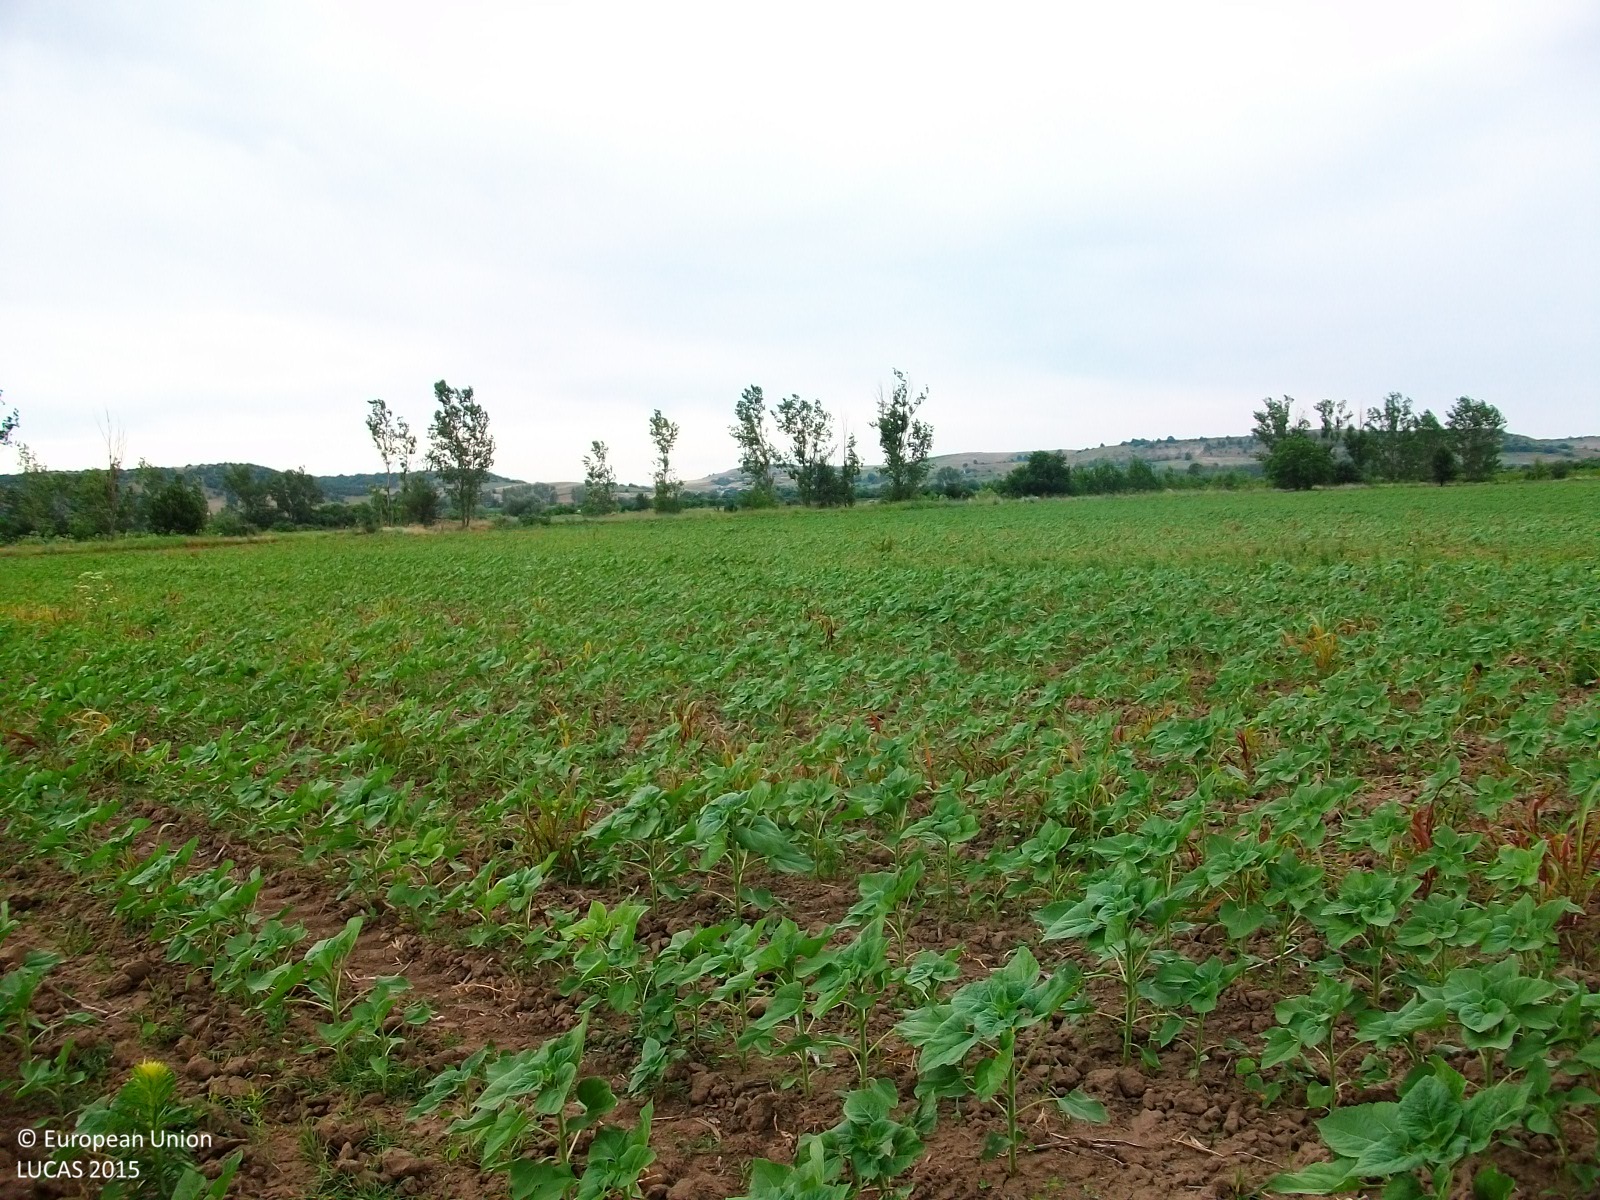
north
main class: Cropland
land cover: Sunflower
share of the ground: 10 - 25 %
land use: Agriculture (excluding fallow land and kitchen gardens)
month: June
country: GR
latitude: 41.6466
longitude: 26.3463
